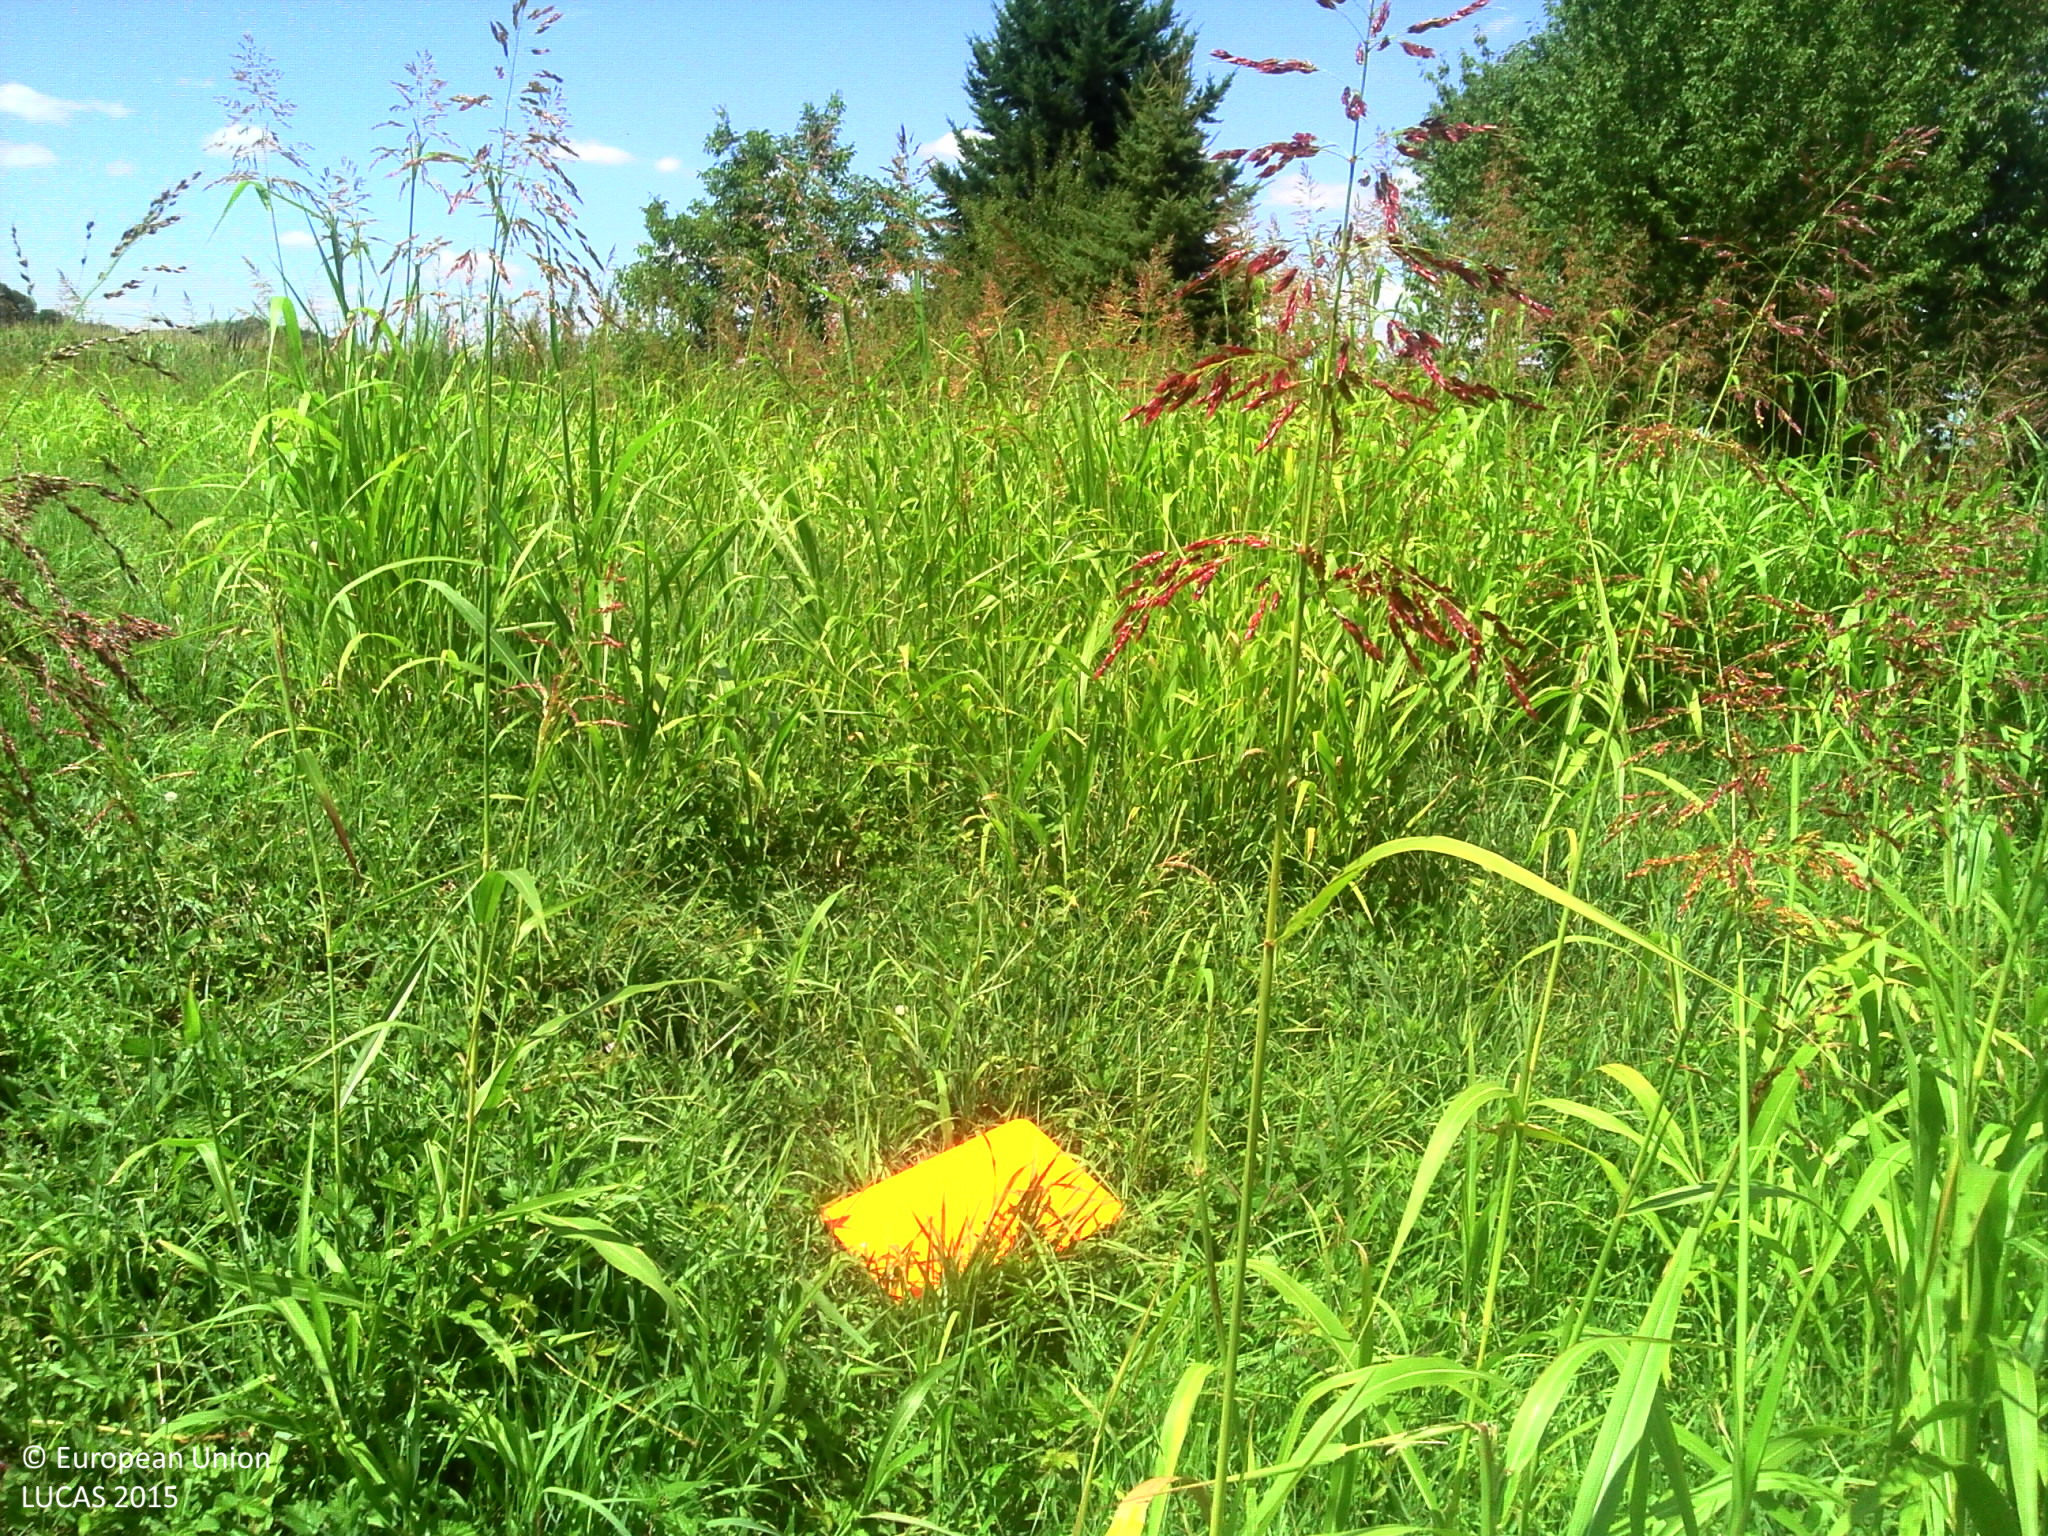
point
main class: Grassland
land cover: Spontaneously vegetated surfaces
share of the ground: > 75 %
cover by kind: herbaceous plants 100 %
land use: Agriculture (excluding fallow land and kitchen gardens)
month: July
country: FR
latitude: 45.6769
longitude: 5.4468
